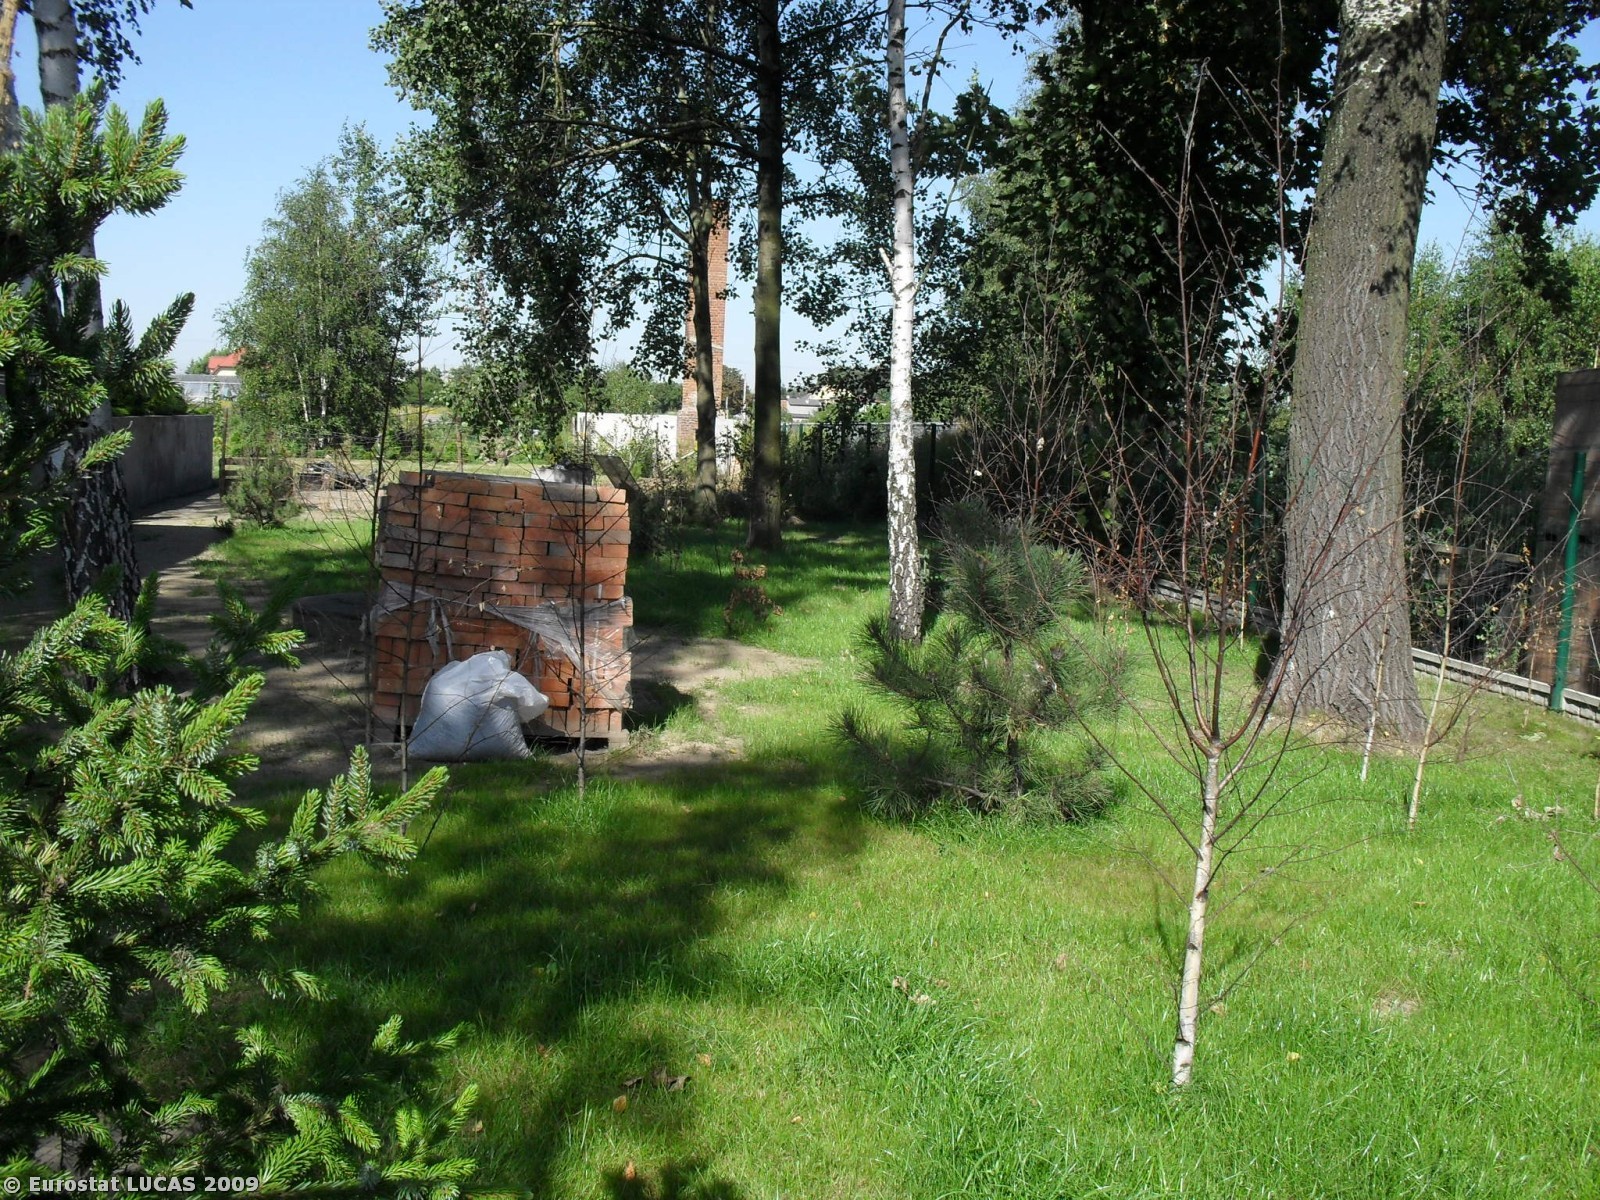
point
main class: Grassland
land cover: Grassland with sparse tree/shrub cover
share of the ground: > 75 %
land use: Residential
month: August
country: PL
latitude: 51.6769
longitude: 19.4127
